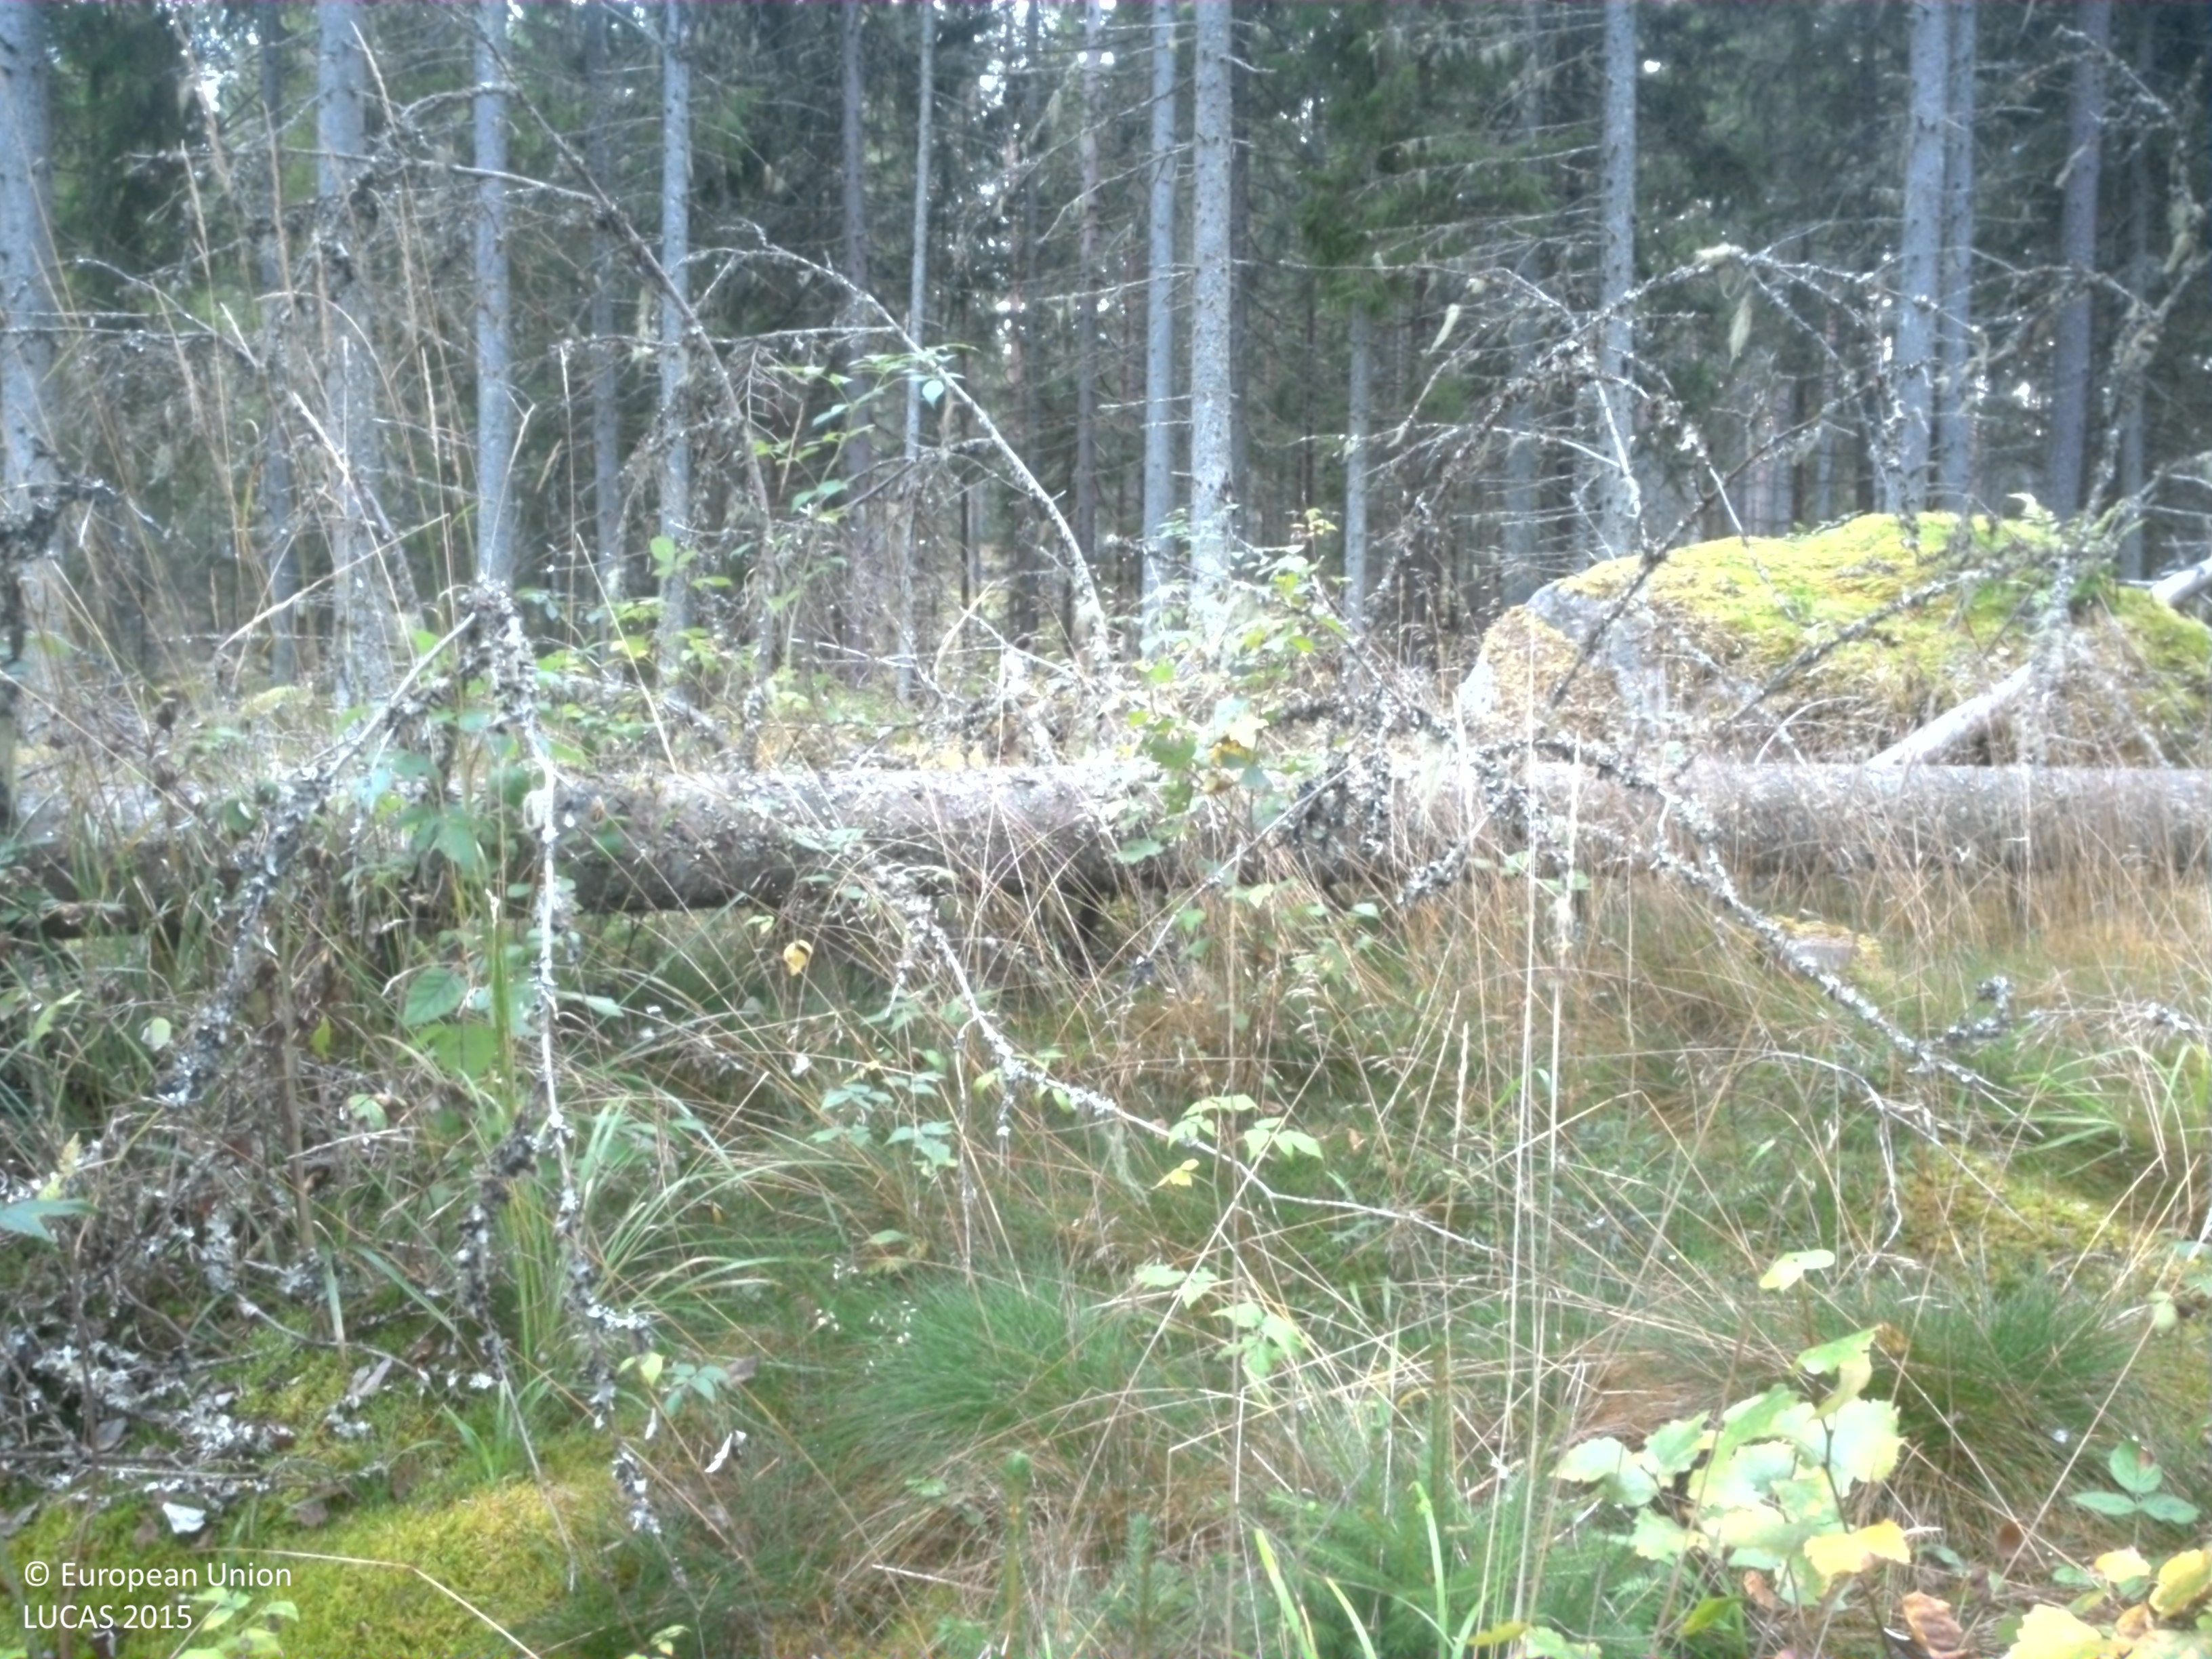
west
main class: Woodland
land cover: Spruce dominated coniferous woodland
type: boreal forest
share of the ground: 50 - 75 %
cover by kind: coniferous forest trees 60 %, lichens and mosses 25 %, herbaceous plants 10 %, shrubs 5 %
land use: Forestry
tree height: > 5 m
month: September
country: SE
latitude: 59.6165
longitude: 15.6452
